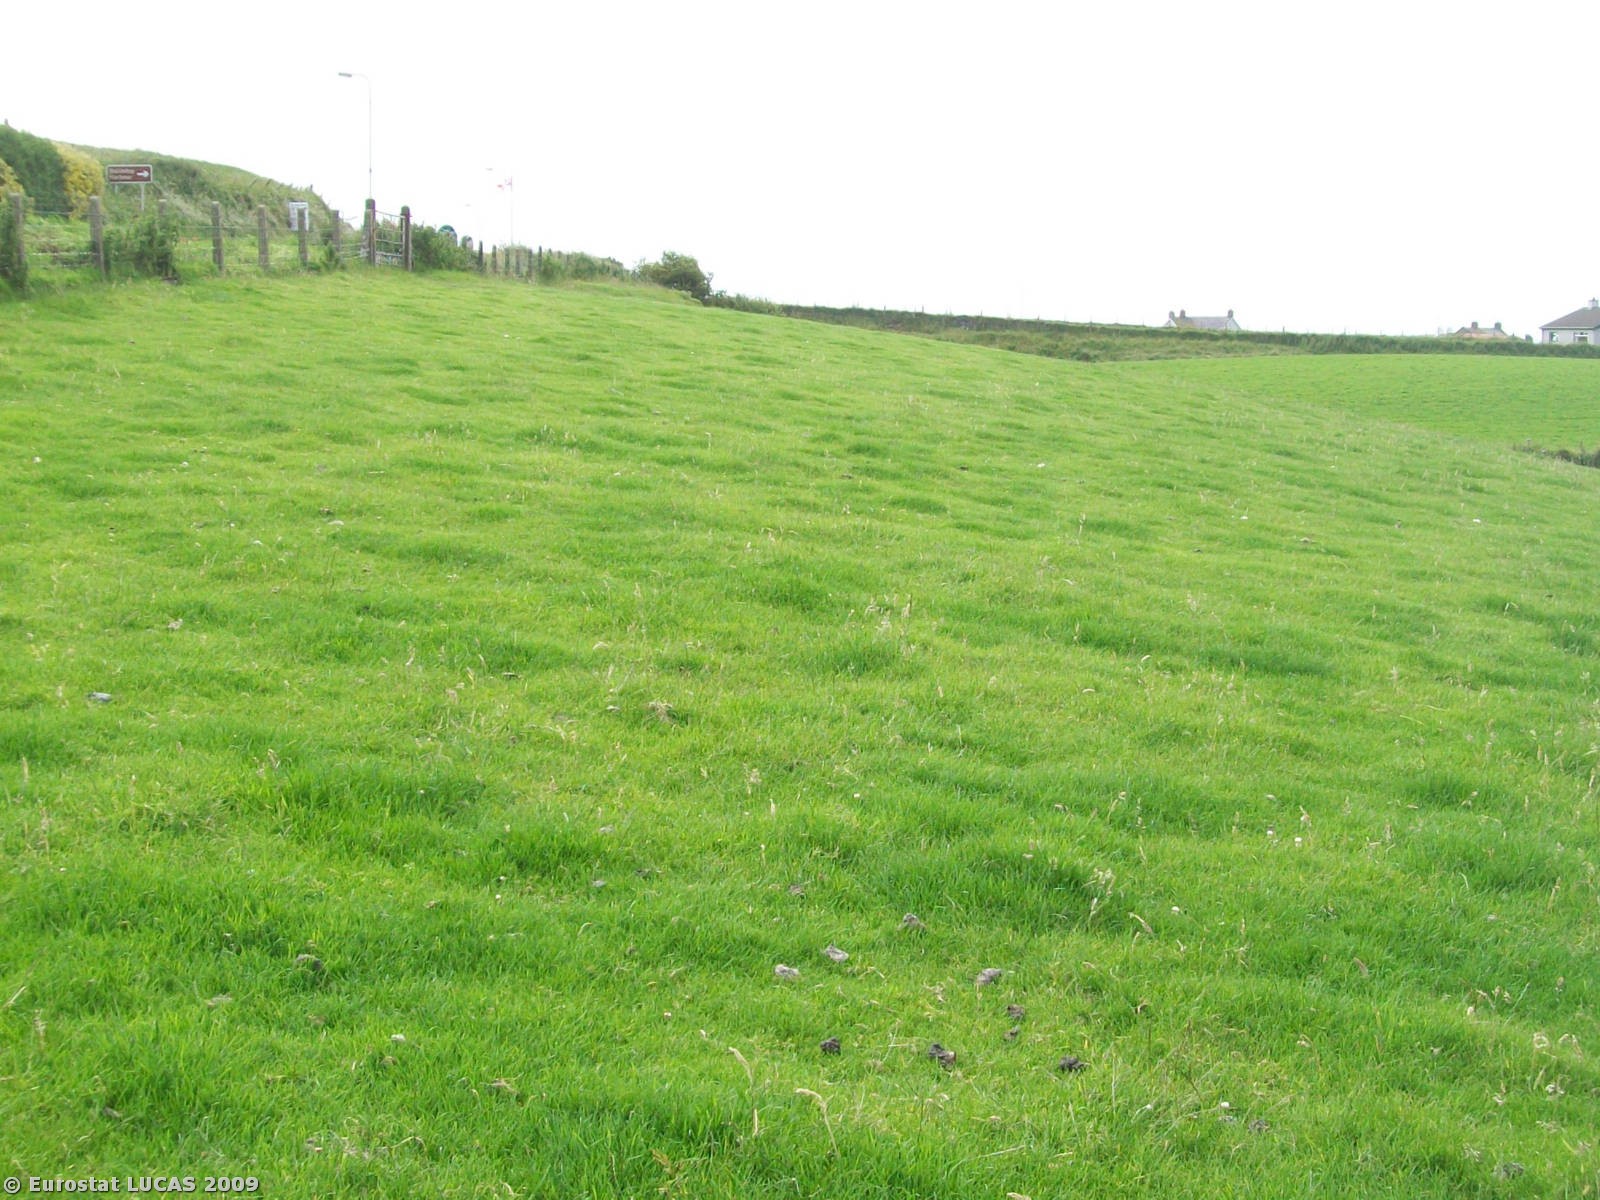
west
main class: Grassland
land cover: Grassland without tree/shrub cover
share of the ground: > 75 %
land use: Agriculture (excluding fallow land and kitchen gardens)
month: July
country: GB
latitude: 55.2369
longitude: -6.3625
